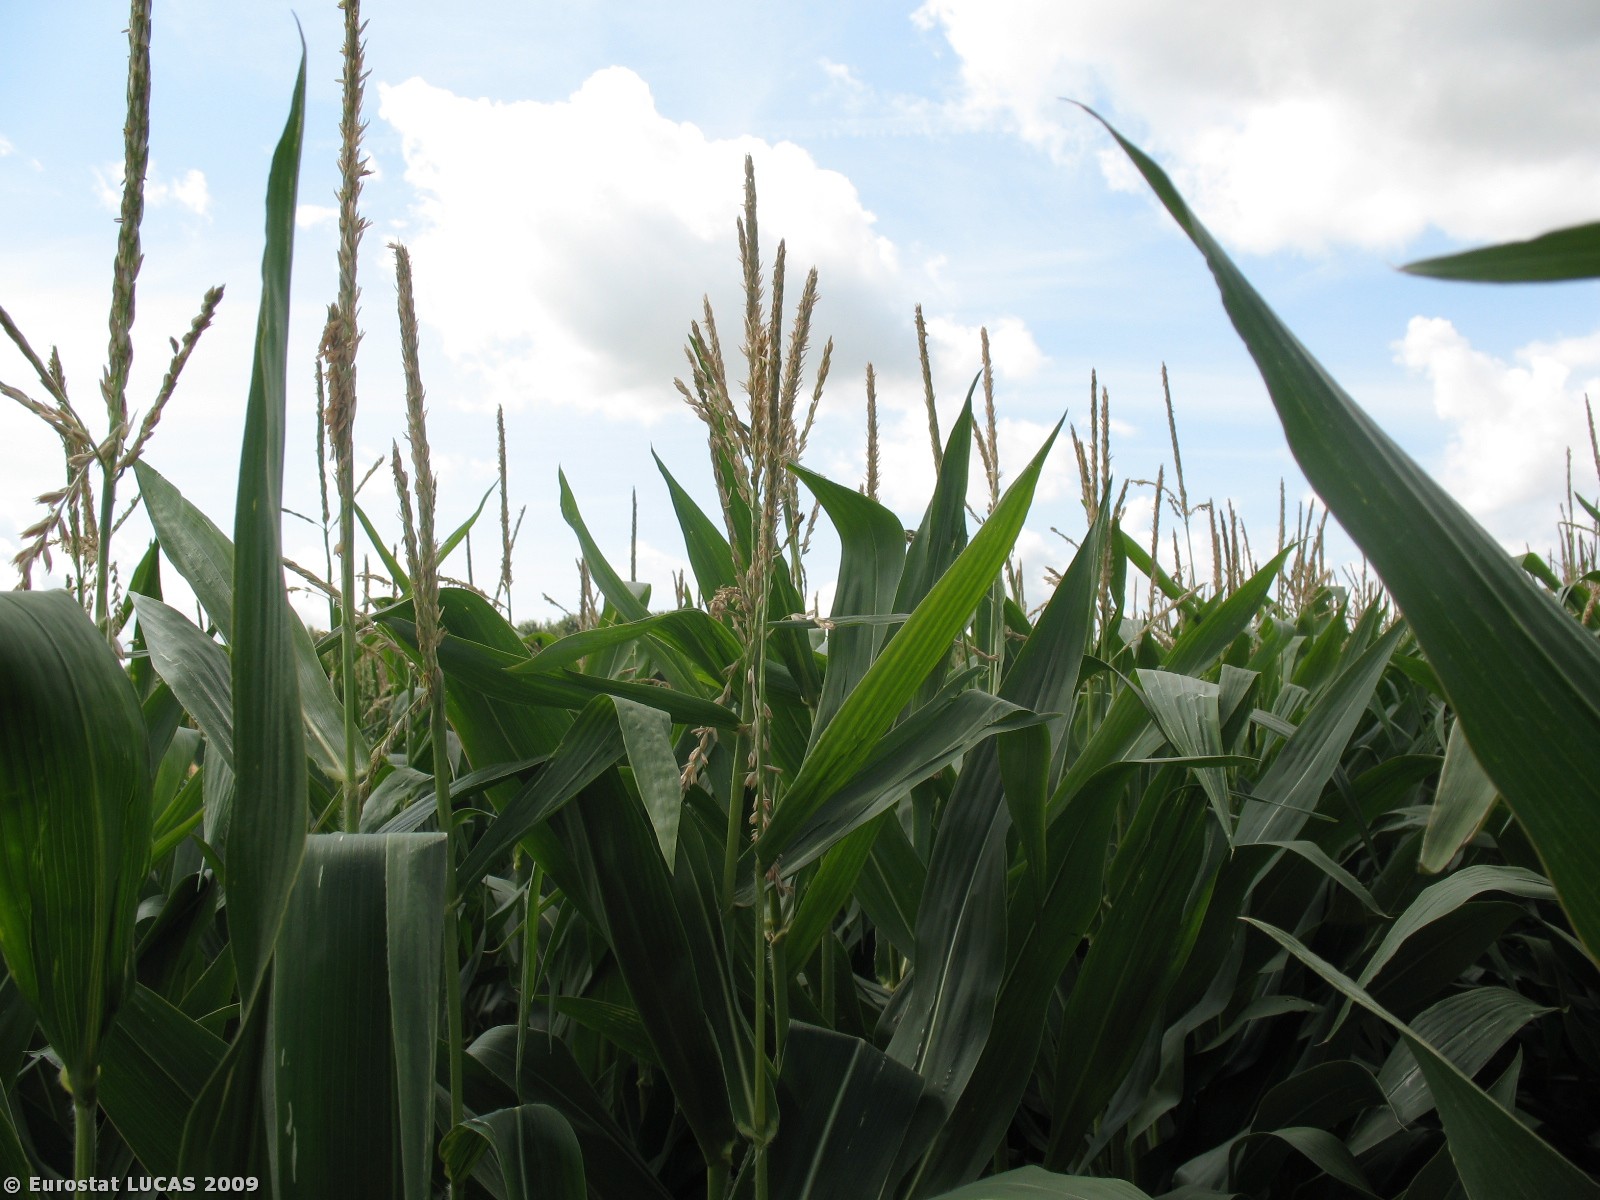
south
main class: Cropland
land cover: Maize
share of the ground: > 75 %
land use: Agriculture (excluding fallow land and kitchen gardens)
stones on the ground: < 10 %
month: July
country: BE
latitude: 50.8592
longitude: 3.7280
